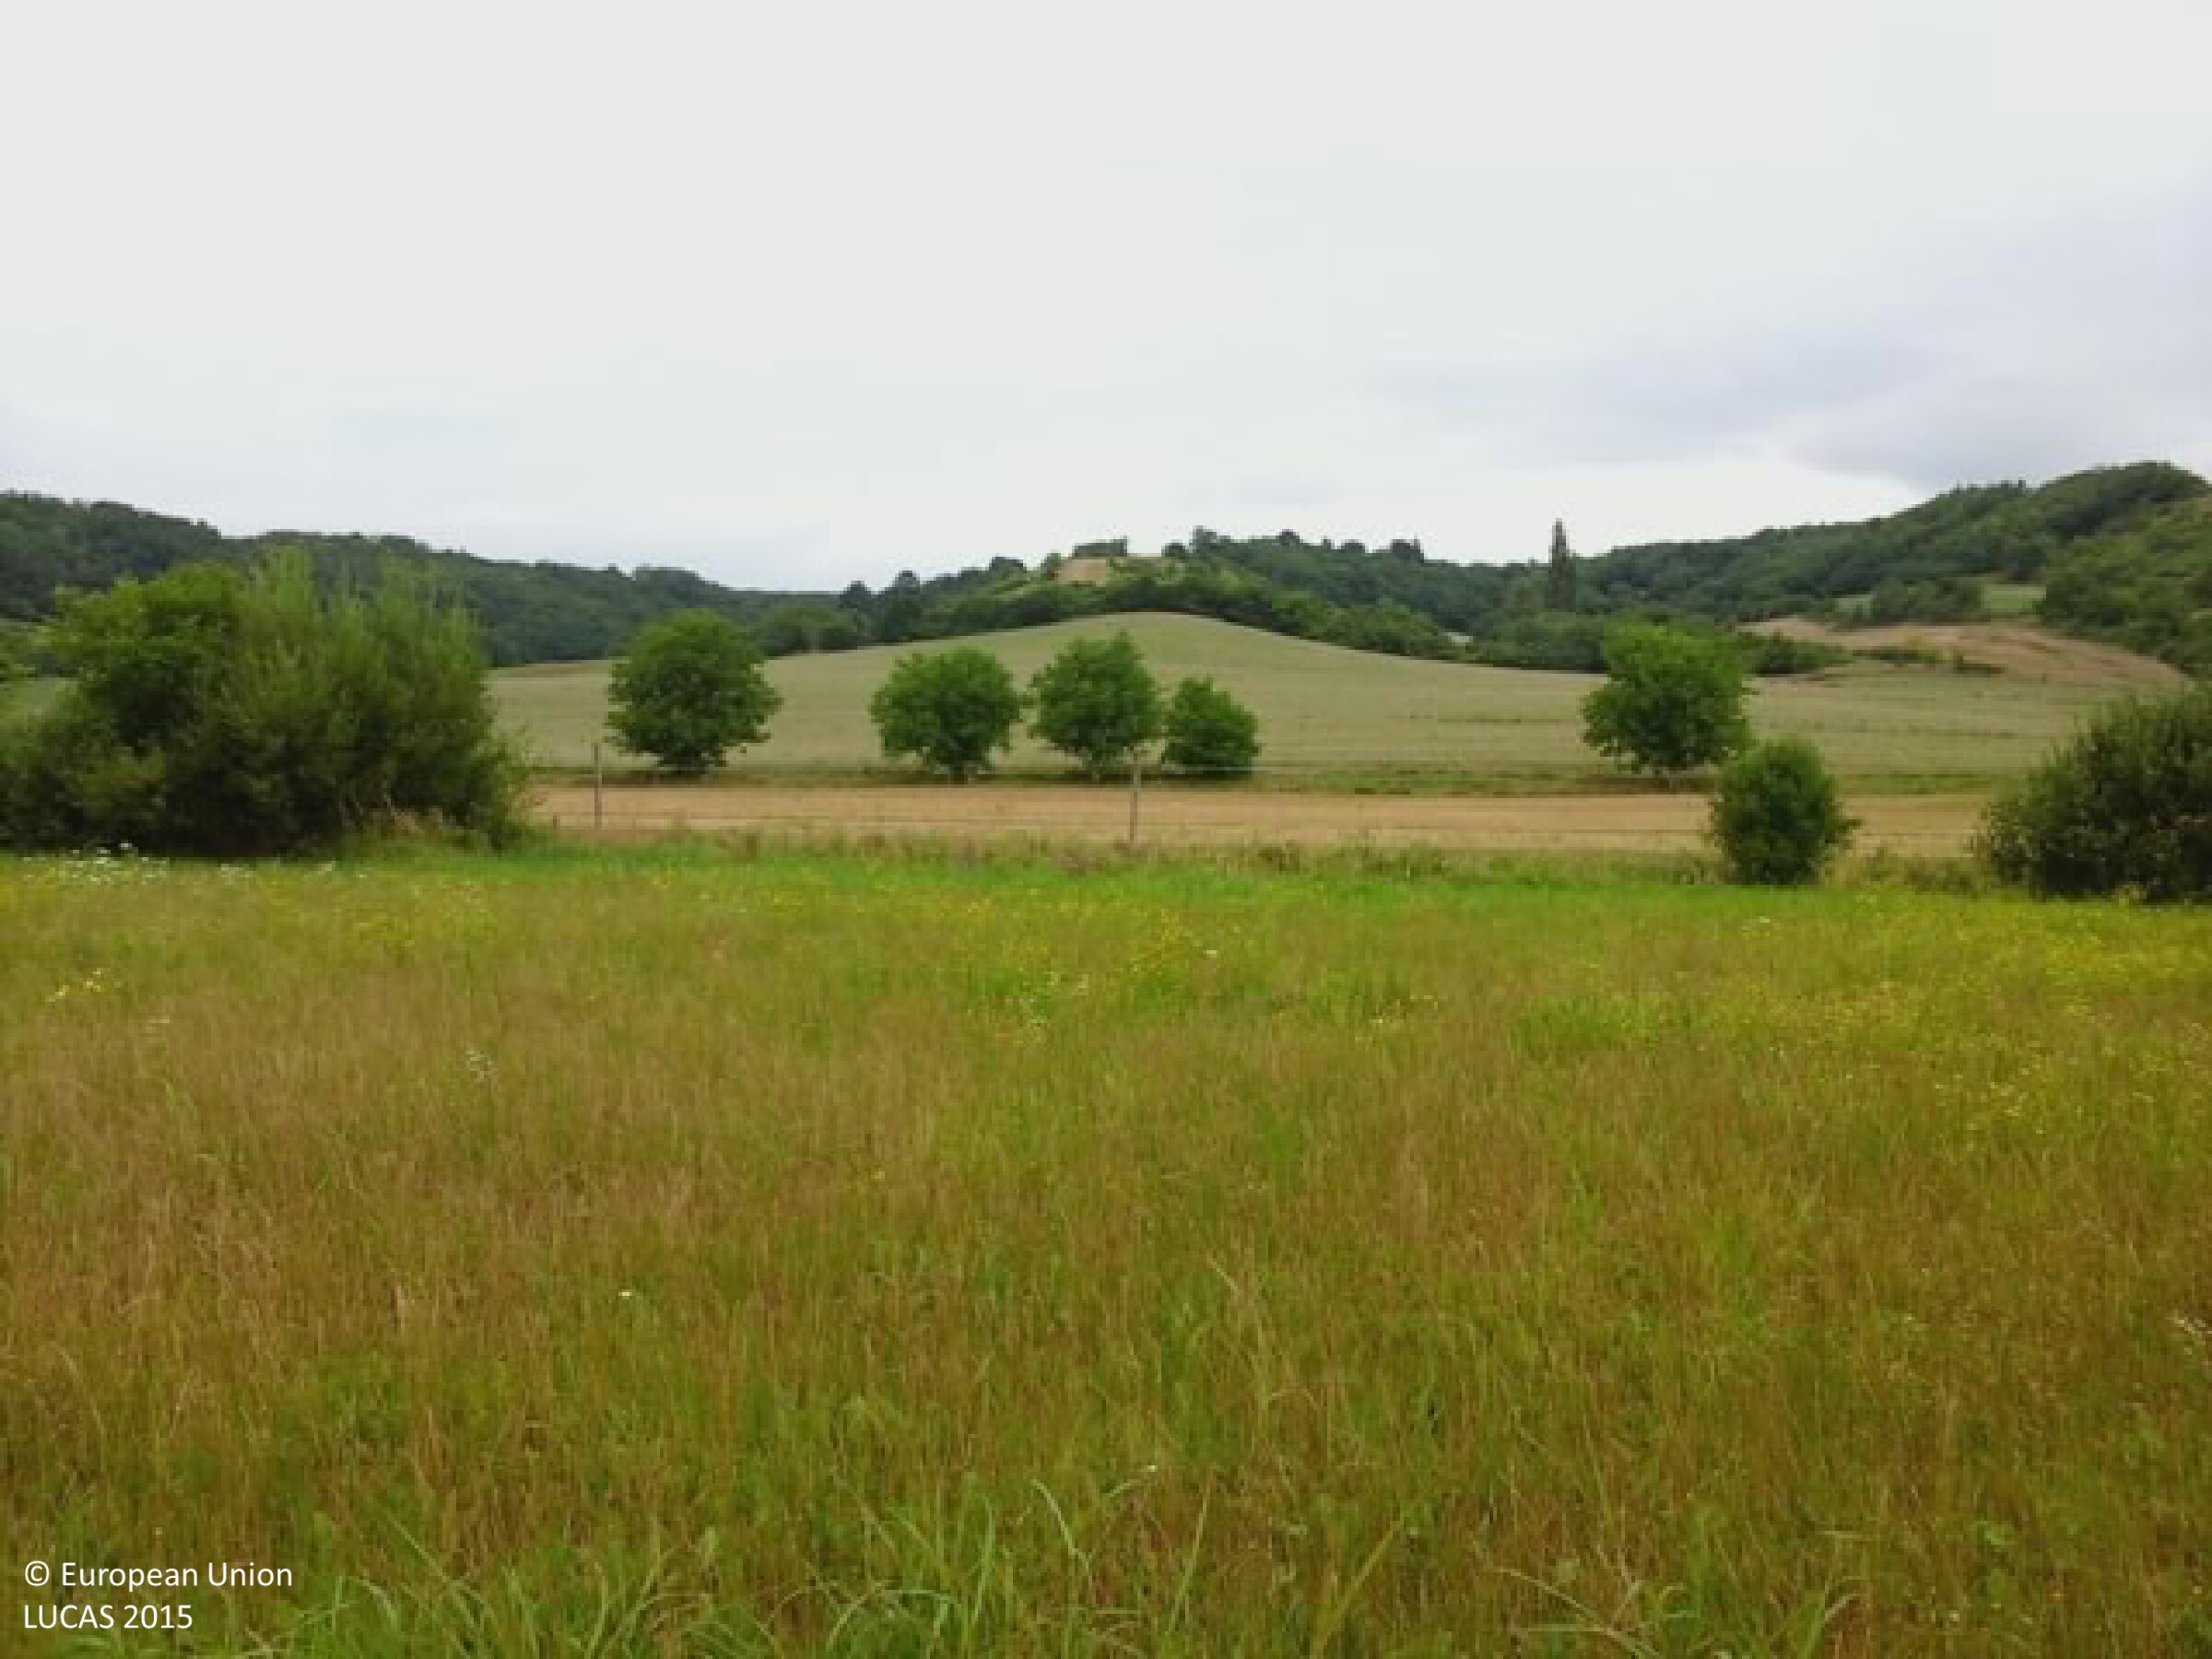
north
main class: Grassland
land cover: Grassland without tree/shrub cover
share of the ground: > 75 %
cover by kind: herbaceous plants 100 %
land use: Agriculture (excluding fallow land and kitchen gardens)
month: July
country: HU
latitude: 46.2138
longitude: 18.0043
